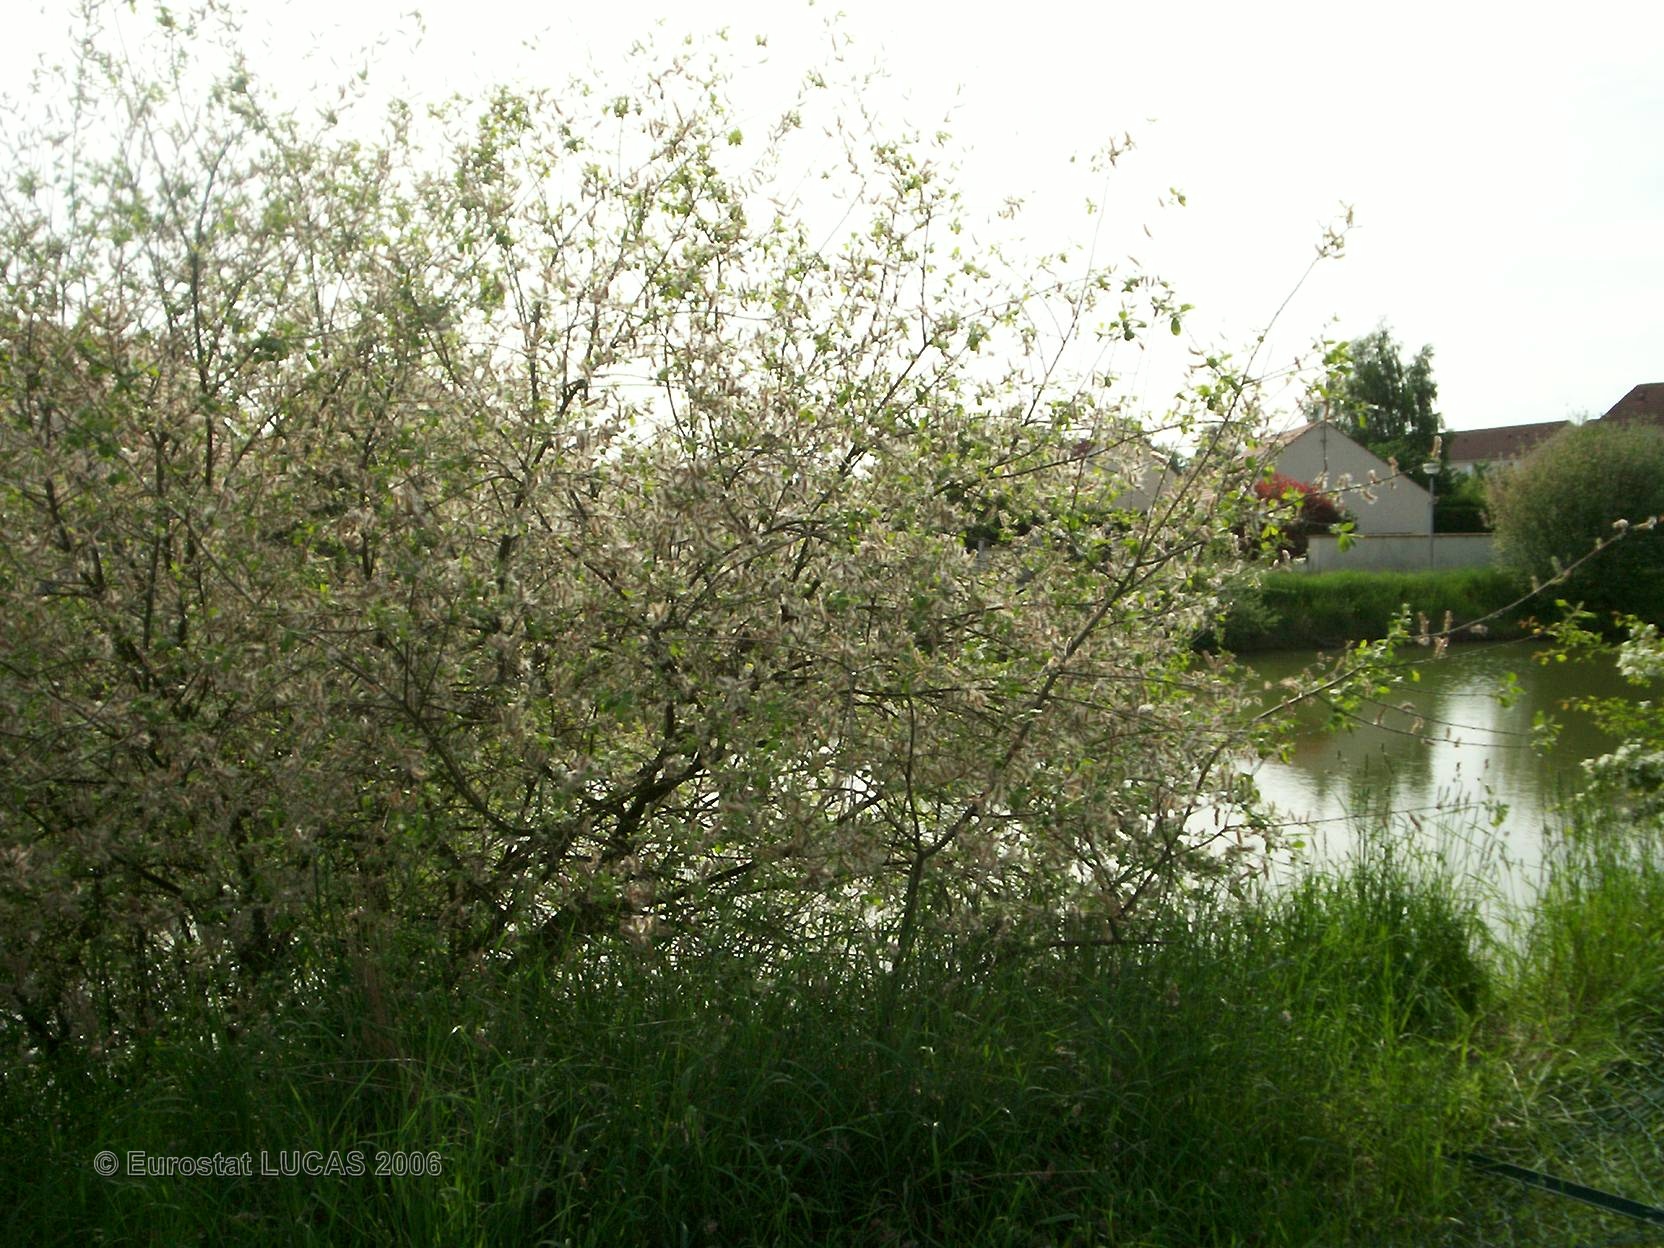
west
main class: Grassland
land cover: Grassland with sparse tree/shrub cover
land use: Amenities, museums, leisure
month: May
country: FR
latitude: 48.6085
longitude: 2.8979
